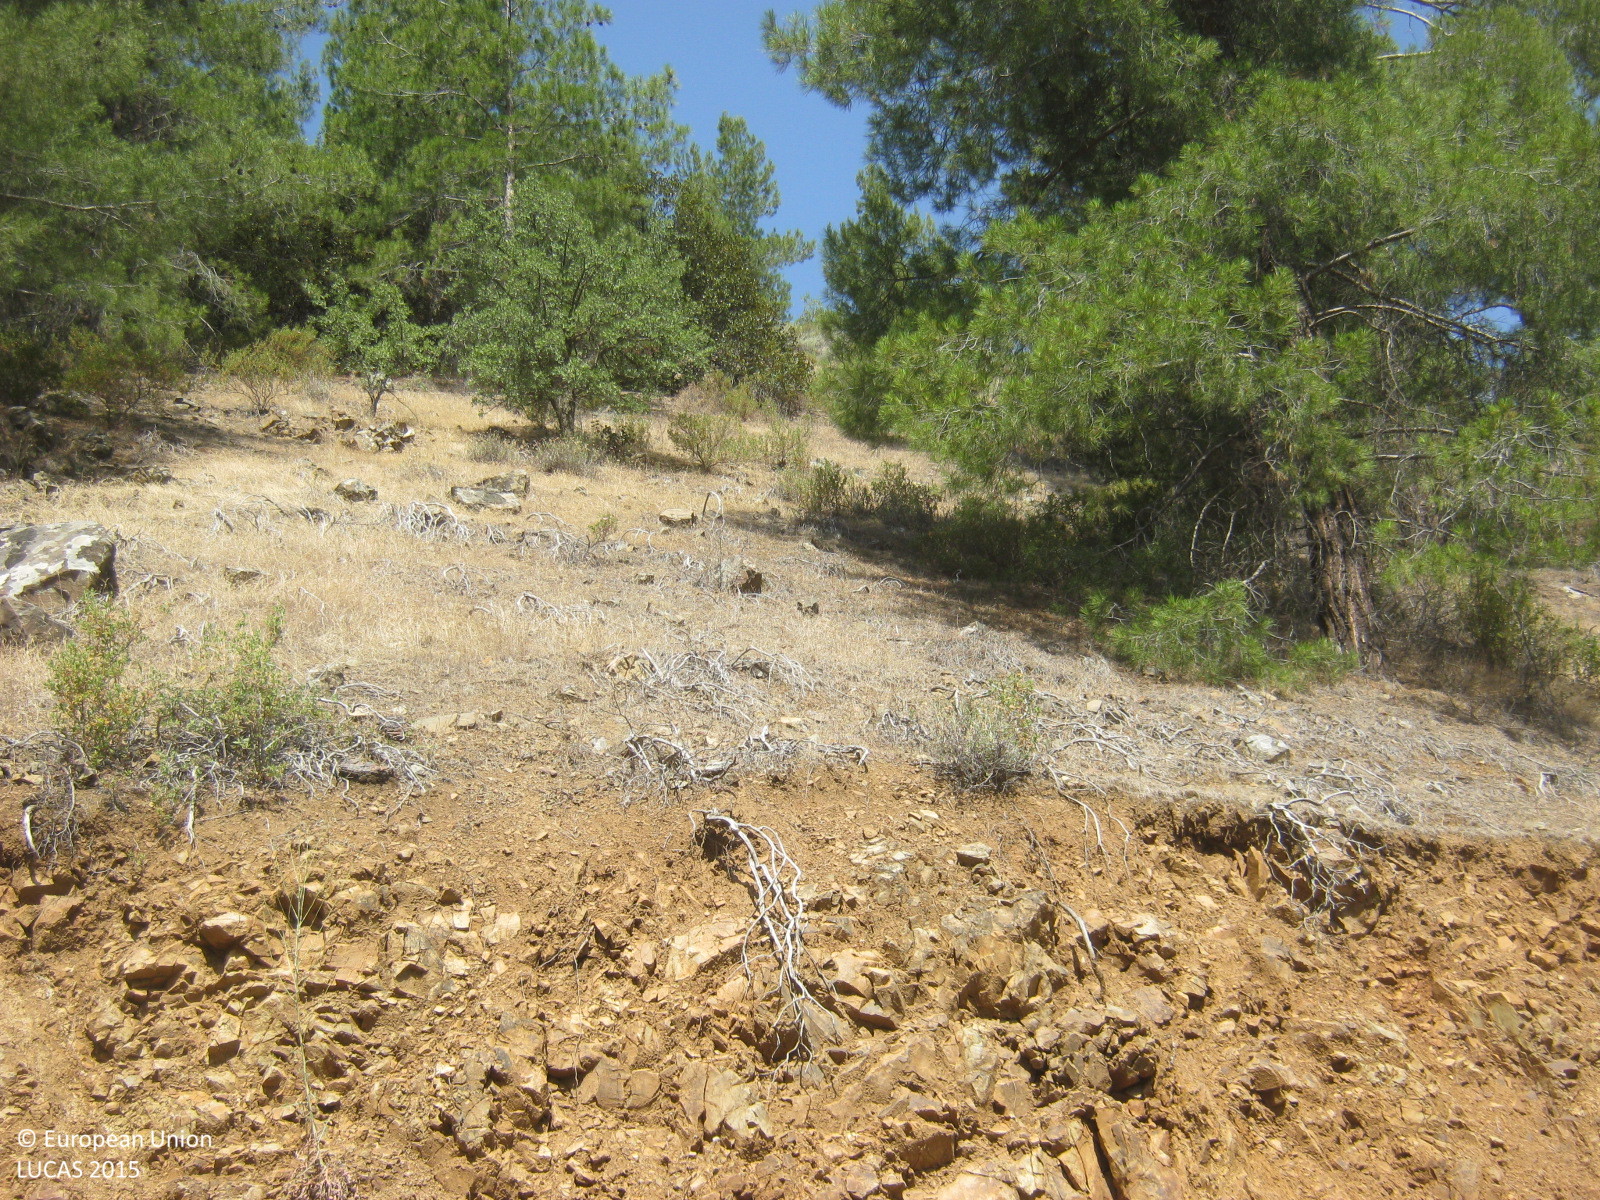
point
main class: Woodland
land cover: Pine dominated mixed woodland
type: coniferous forest of the mediterranean region
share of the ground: 25 - 50 %
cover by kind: coniferous forest trees 40 %, unconsolidated bare surface 20 %, broadleaved forest trees 15 %, shrubs 15 %, herbaceous plants 10 %
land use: Forestry
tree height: > 5 m
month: June
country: CY
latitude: 35.0237
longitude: 32.9815
